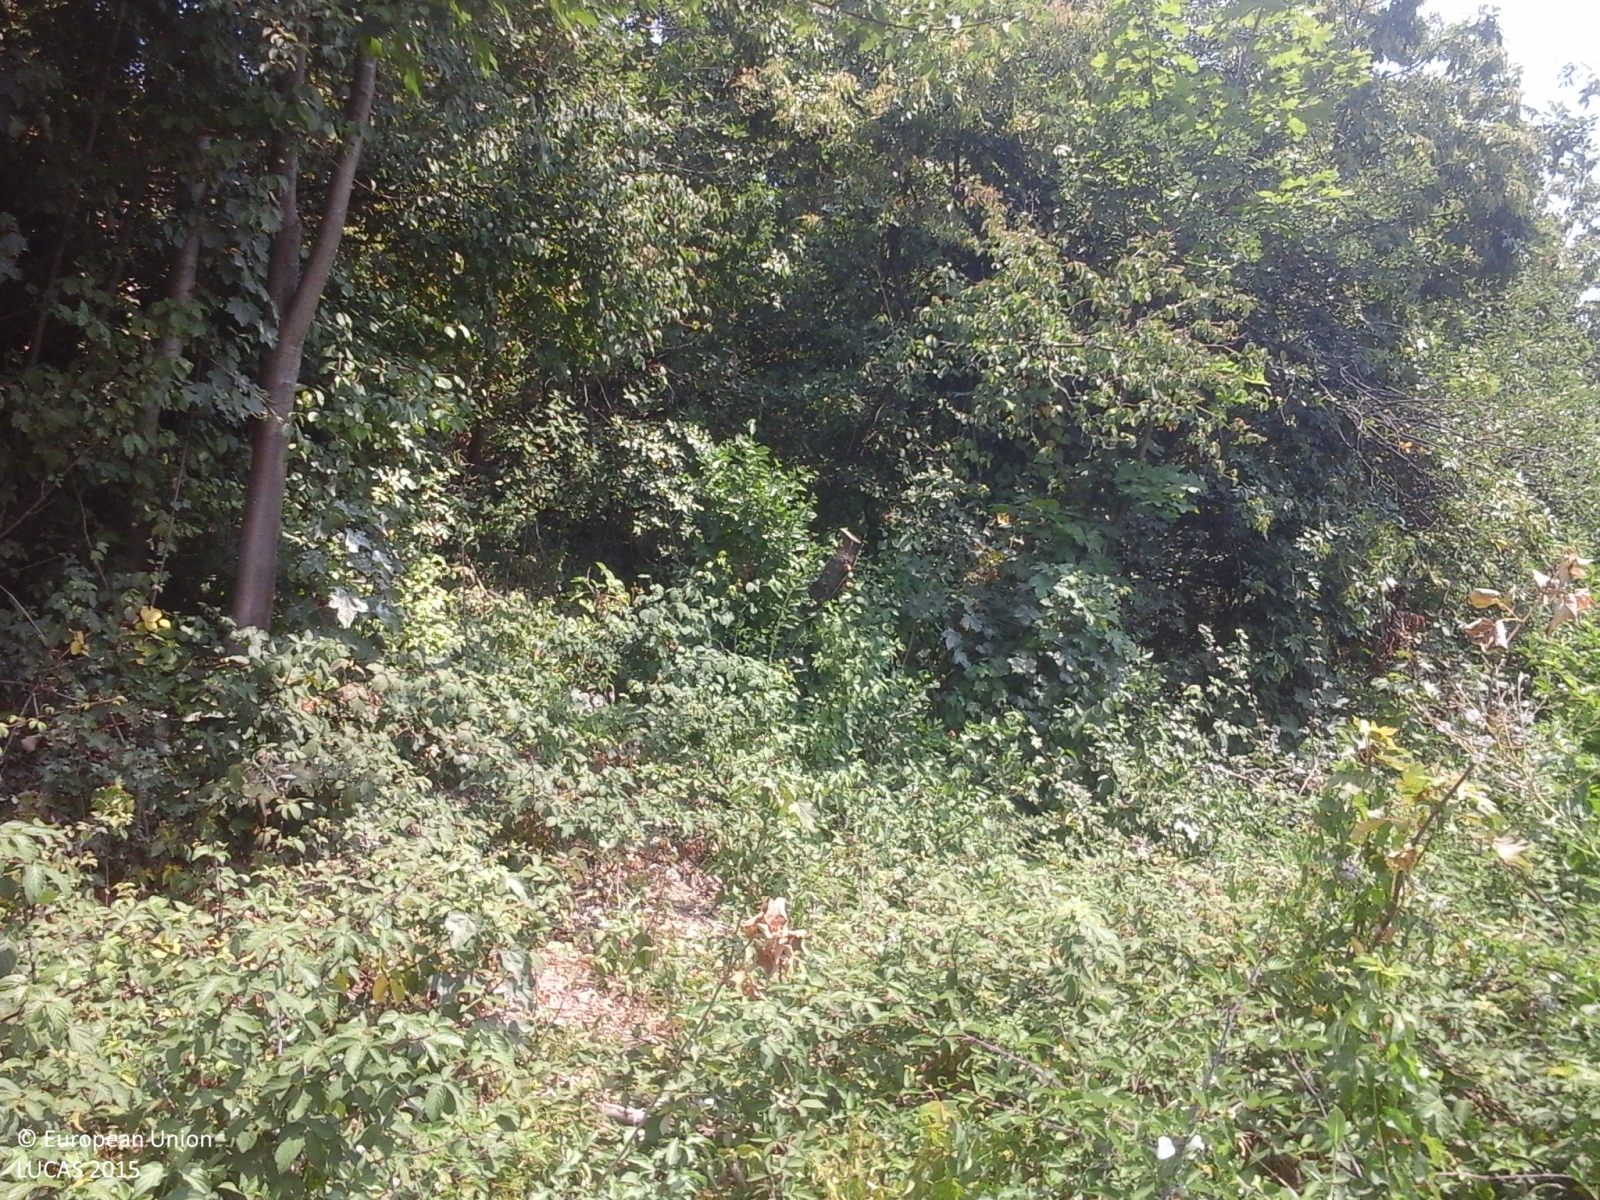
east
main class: Woodland
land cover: Broadleaved woodland
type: thermophilous deciduous forest
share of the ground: > 75 %
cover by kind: broadleaved forest trees 100 %
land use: Forestry
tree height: > 5 m
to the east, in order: Broadleaved woodland; Artificial constructions in urban areas; Olive groves
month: July
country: IT
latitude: 45.7375
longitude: 9.4996
